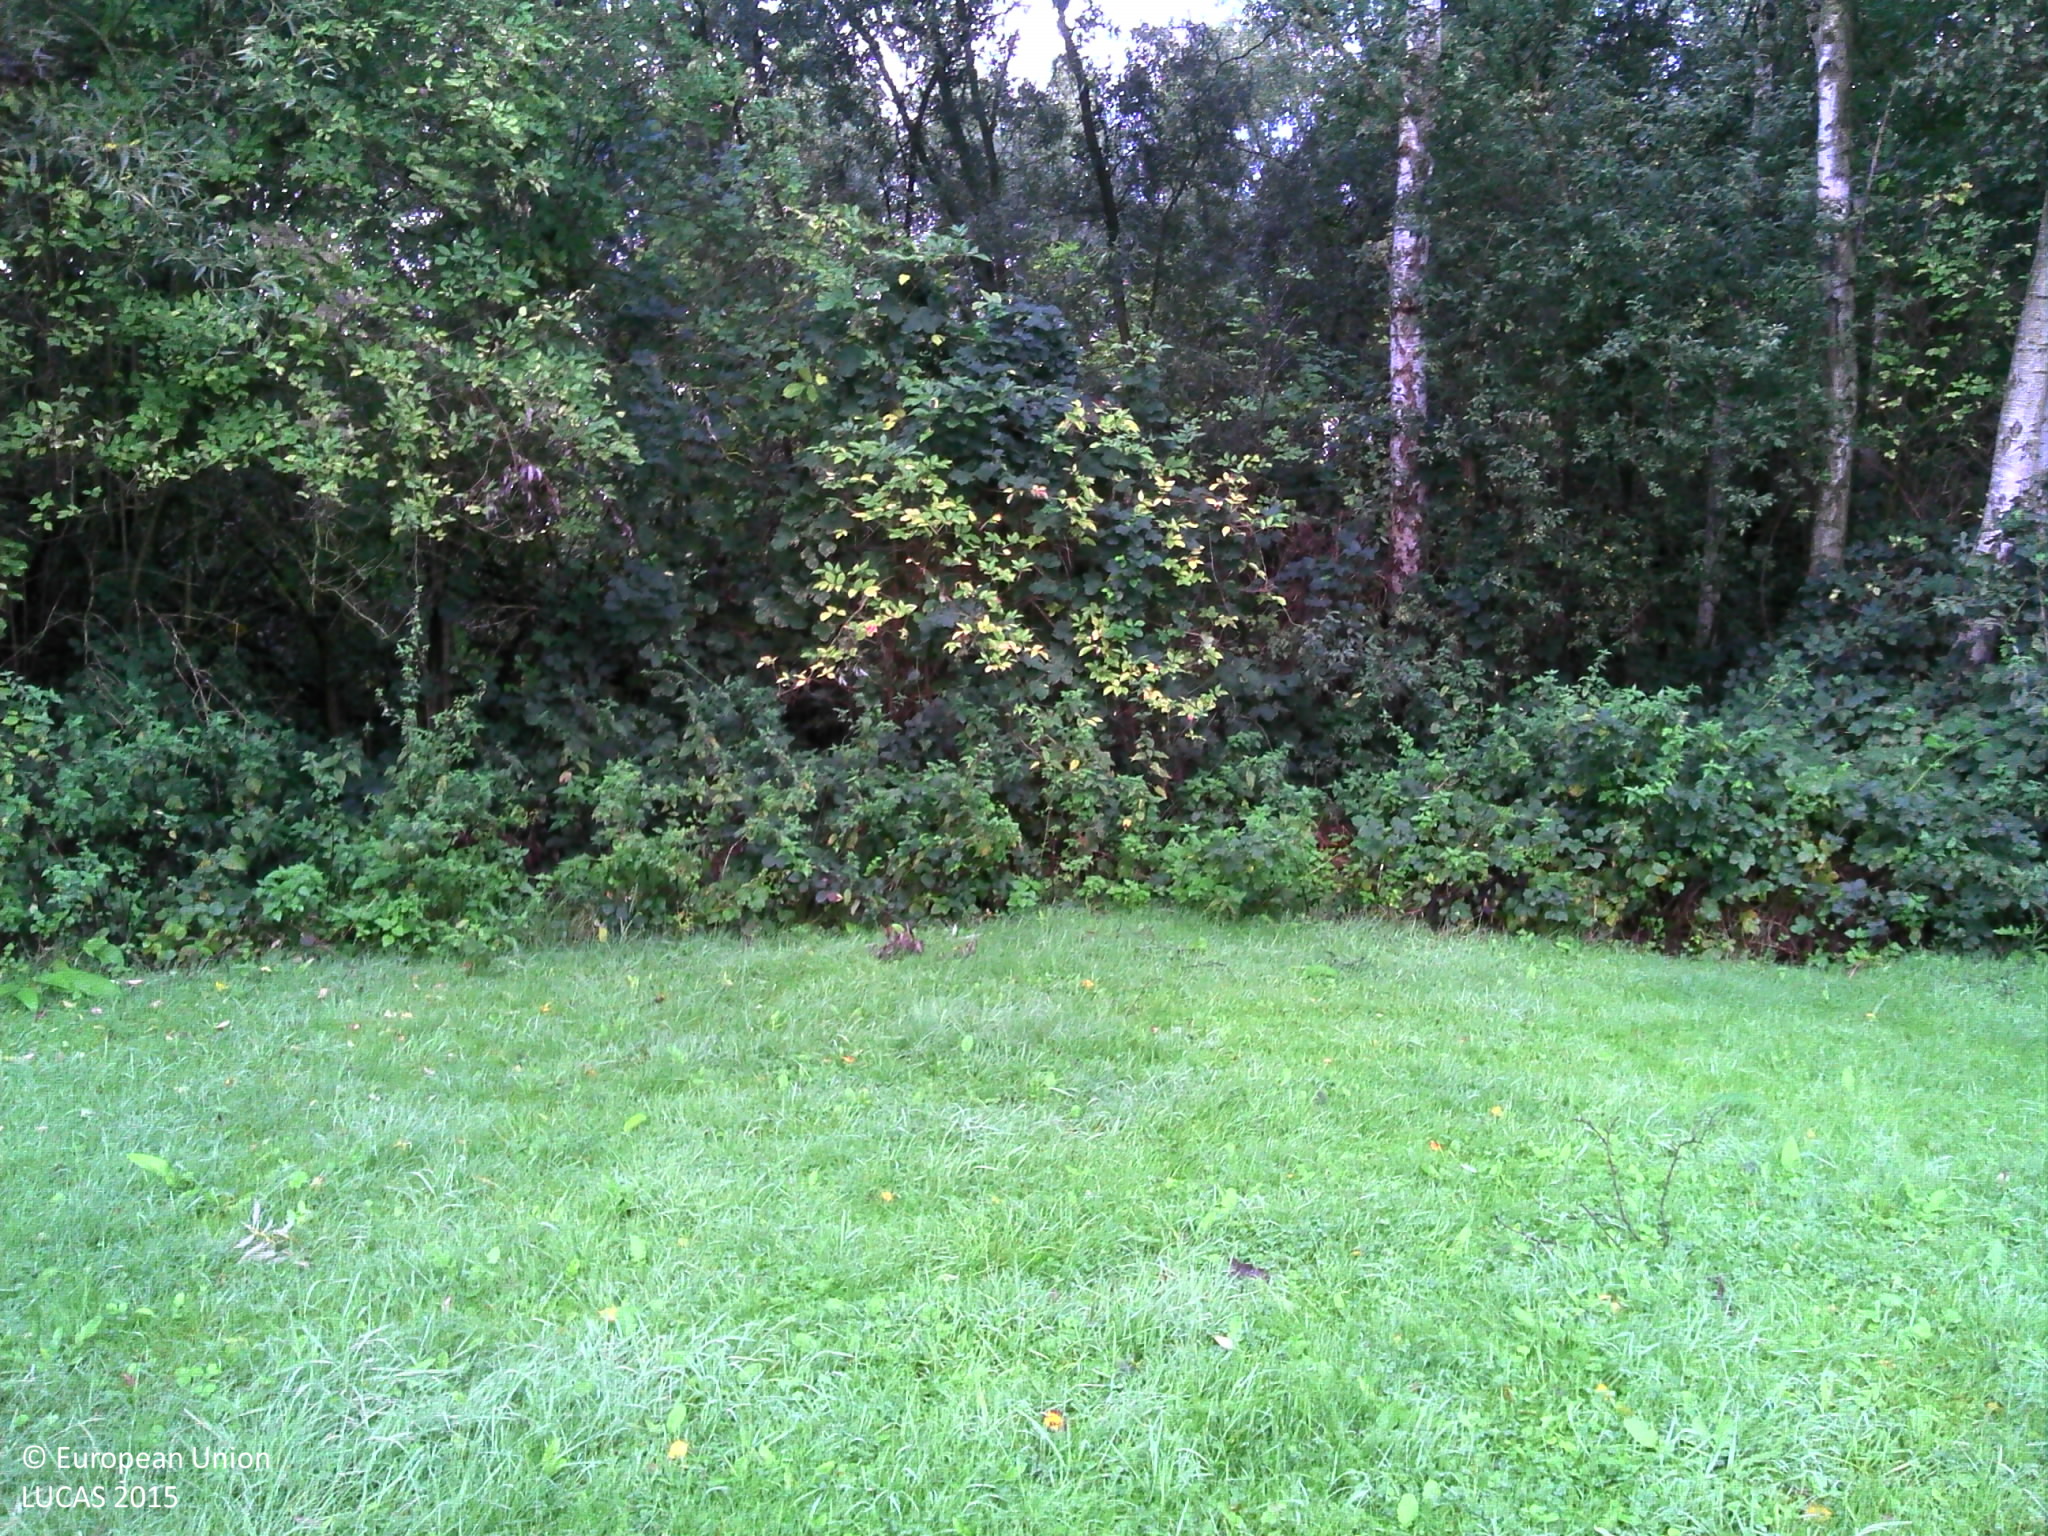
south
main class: Grassland
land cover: Grassland without tree/shrub cover
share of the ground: > 75 %
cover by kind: herbaceous plants 100 %
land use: Road transport
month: September
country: BE
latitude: 51.1078
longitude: 4.3536
